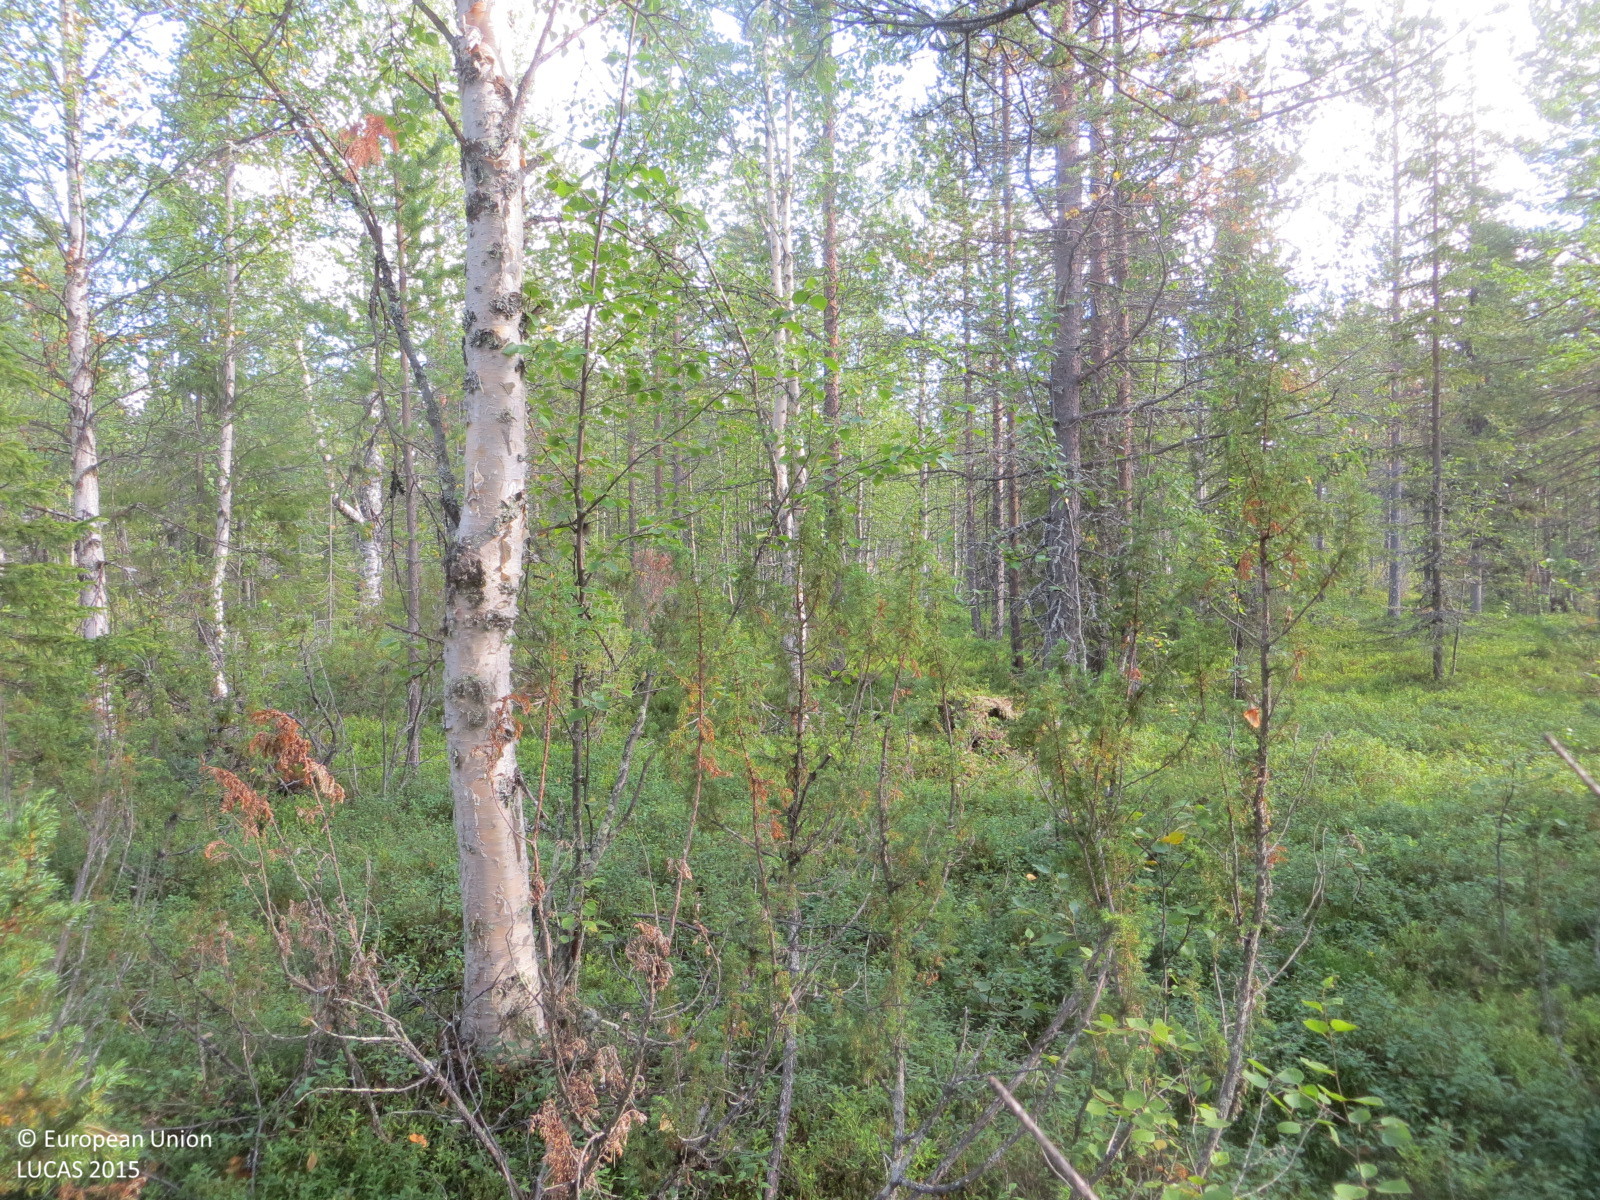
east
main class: Woodland
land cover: Pine dominated mixed woodland
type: boreal forest
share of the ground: 50 - 75 %
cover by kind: shrubs 40 %, coniferous forest trees 30 %, broadleaved forest trees 30 %
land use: Forestry
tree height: > 5 m
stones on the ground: 25 - 50 %
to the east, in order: Pine dominated mixed woodland; Grassland with sparse tree/shrub cover; Spruce dominated coniferous woodland; Ditches and canals; Paved roads, cycling and walking lanes; Ditches and canals; Spruce dominated coniferous woodland; Pine dominated coniferous woodland; Pine dominated mixed woodland
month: August
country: FI
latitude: 68.0204
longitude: 25.7274
